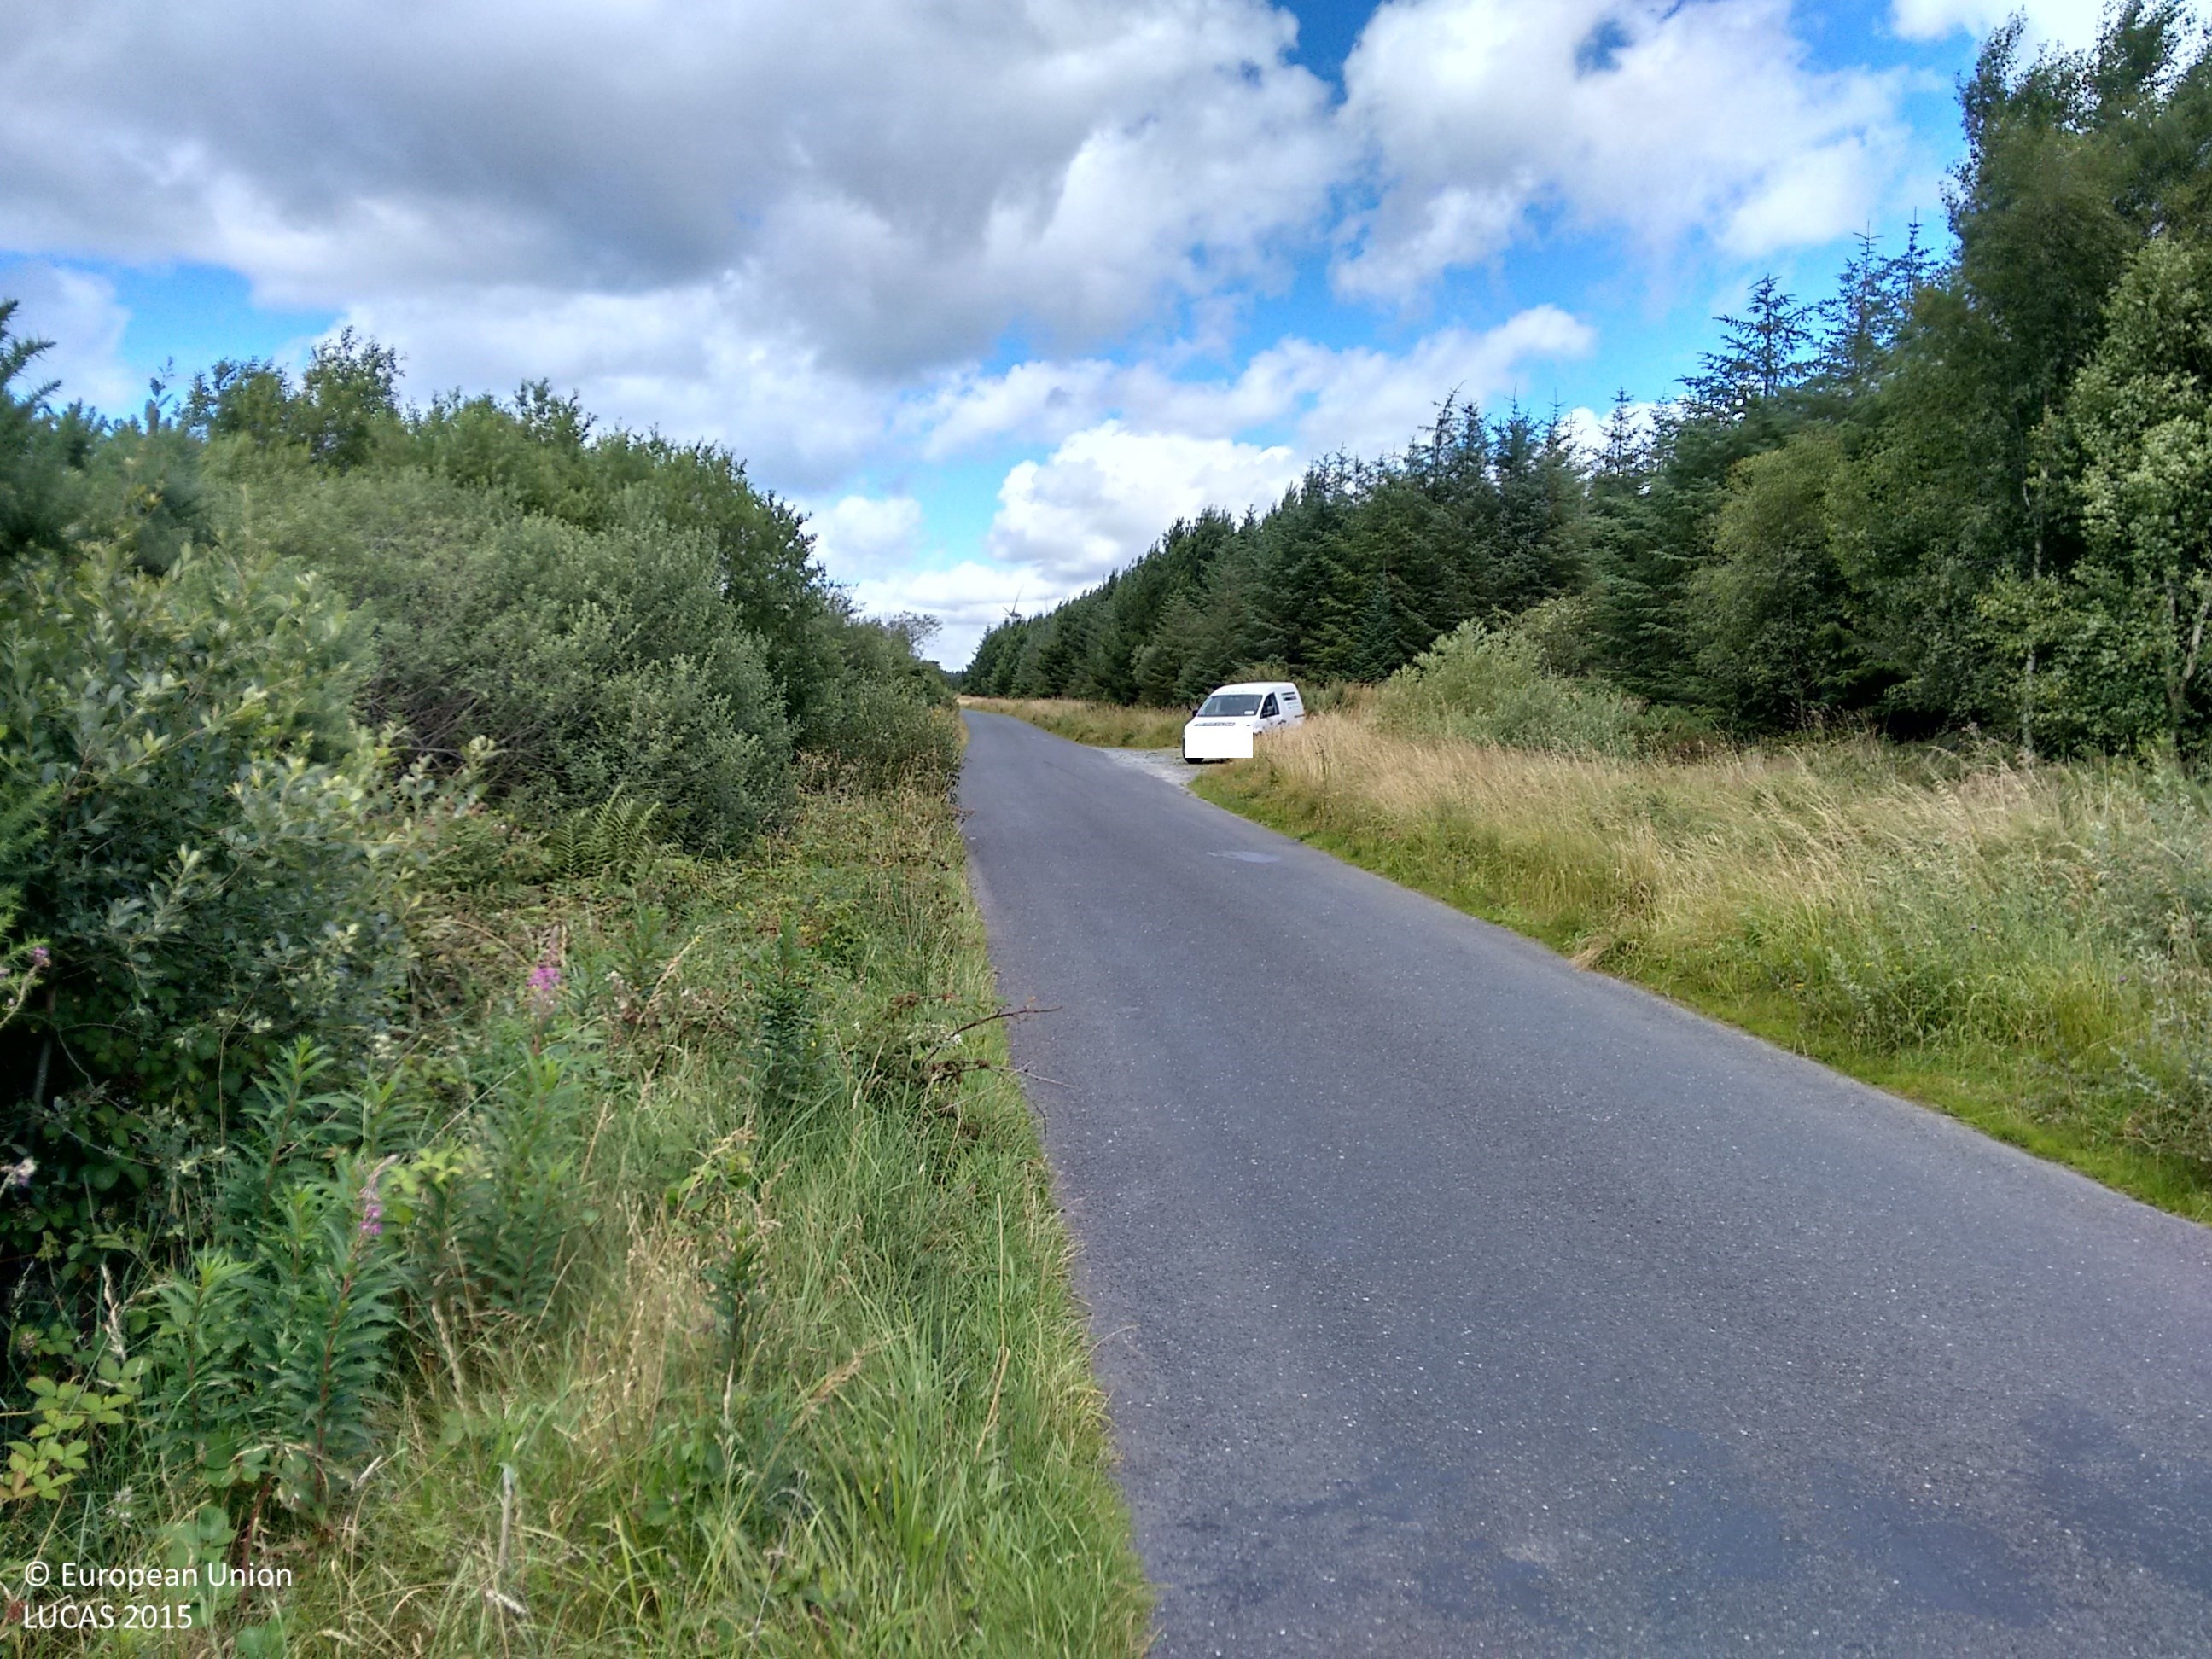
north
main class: Woodland
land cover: Other mixed woodland
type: exotic forest
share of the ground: > 75 %
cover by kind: coniferous forest trees 50 %, broadleaved forest trees 50 %
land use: Forestry
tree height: < 5 m
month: August
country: IE
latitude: 52.3728
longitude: -7.1115
